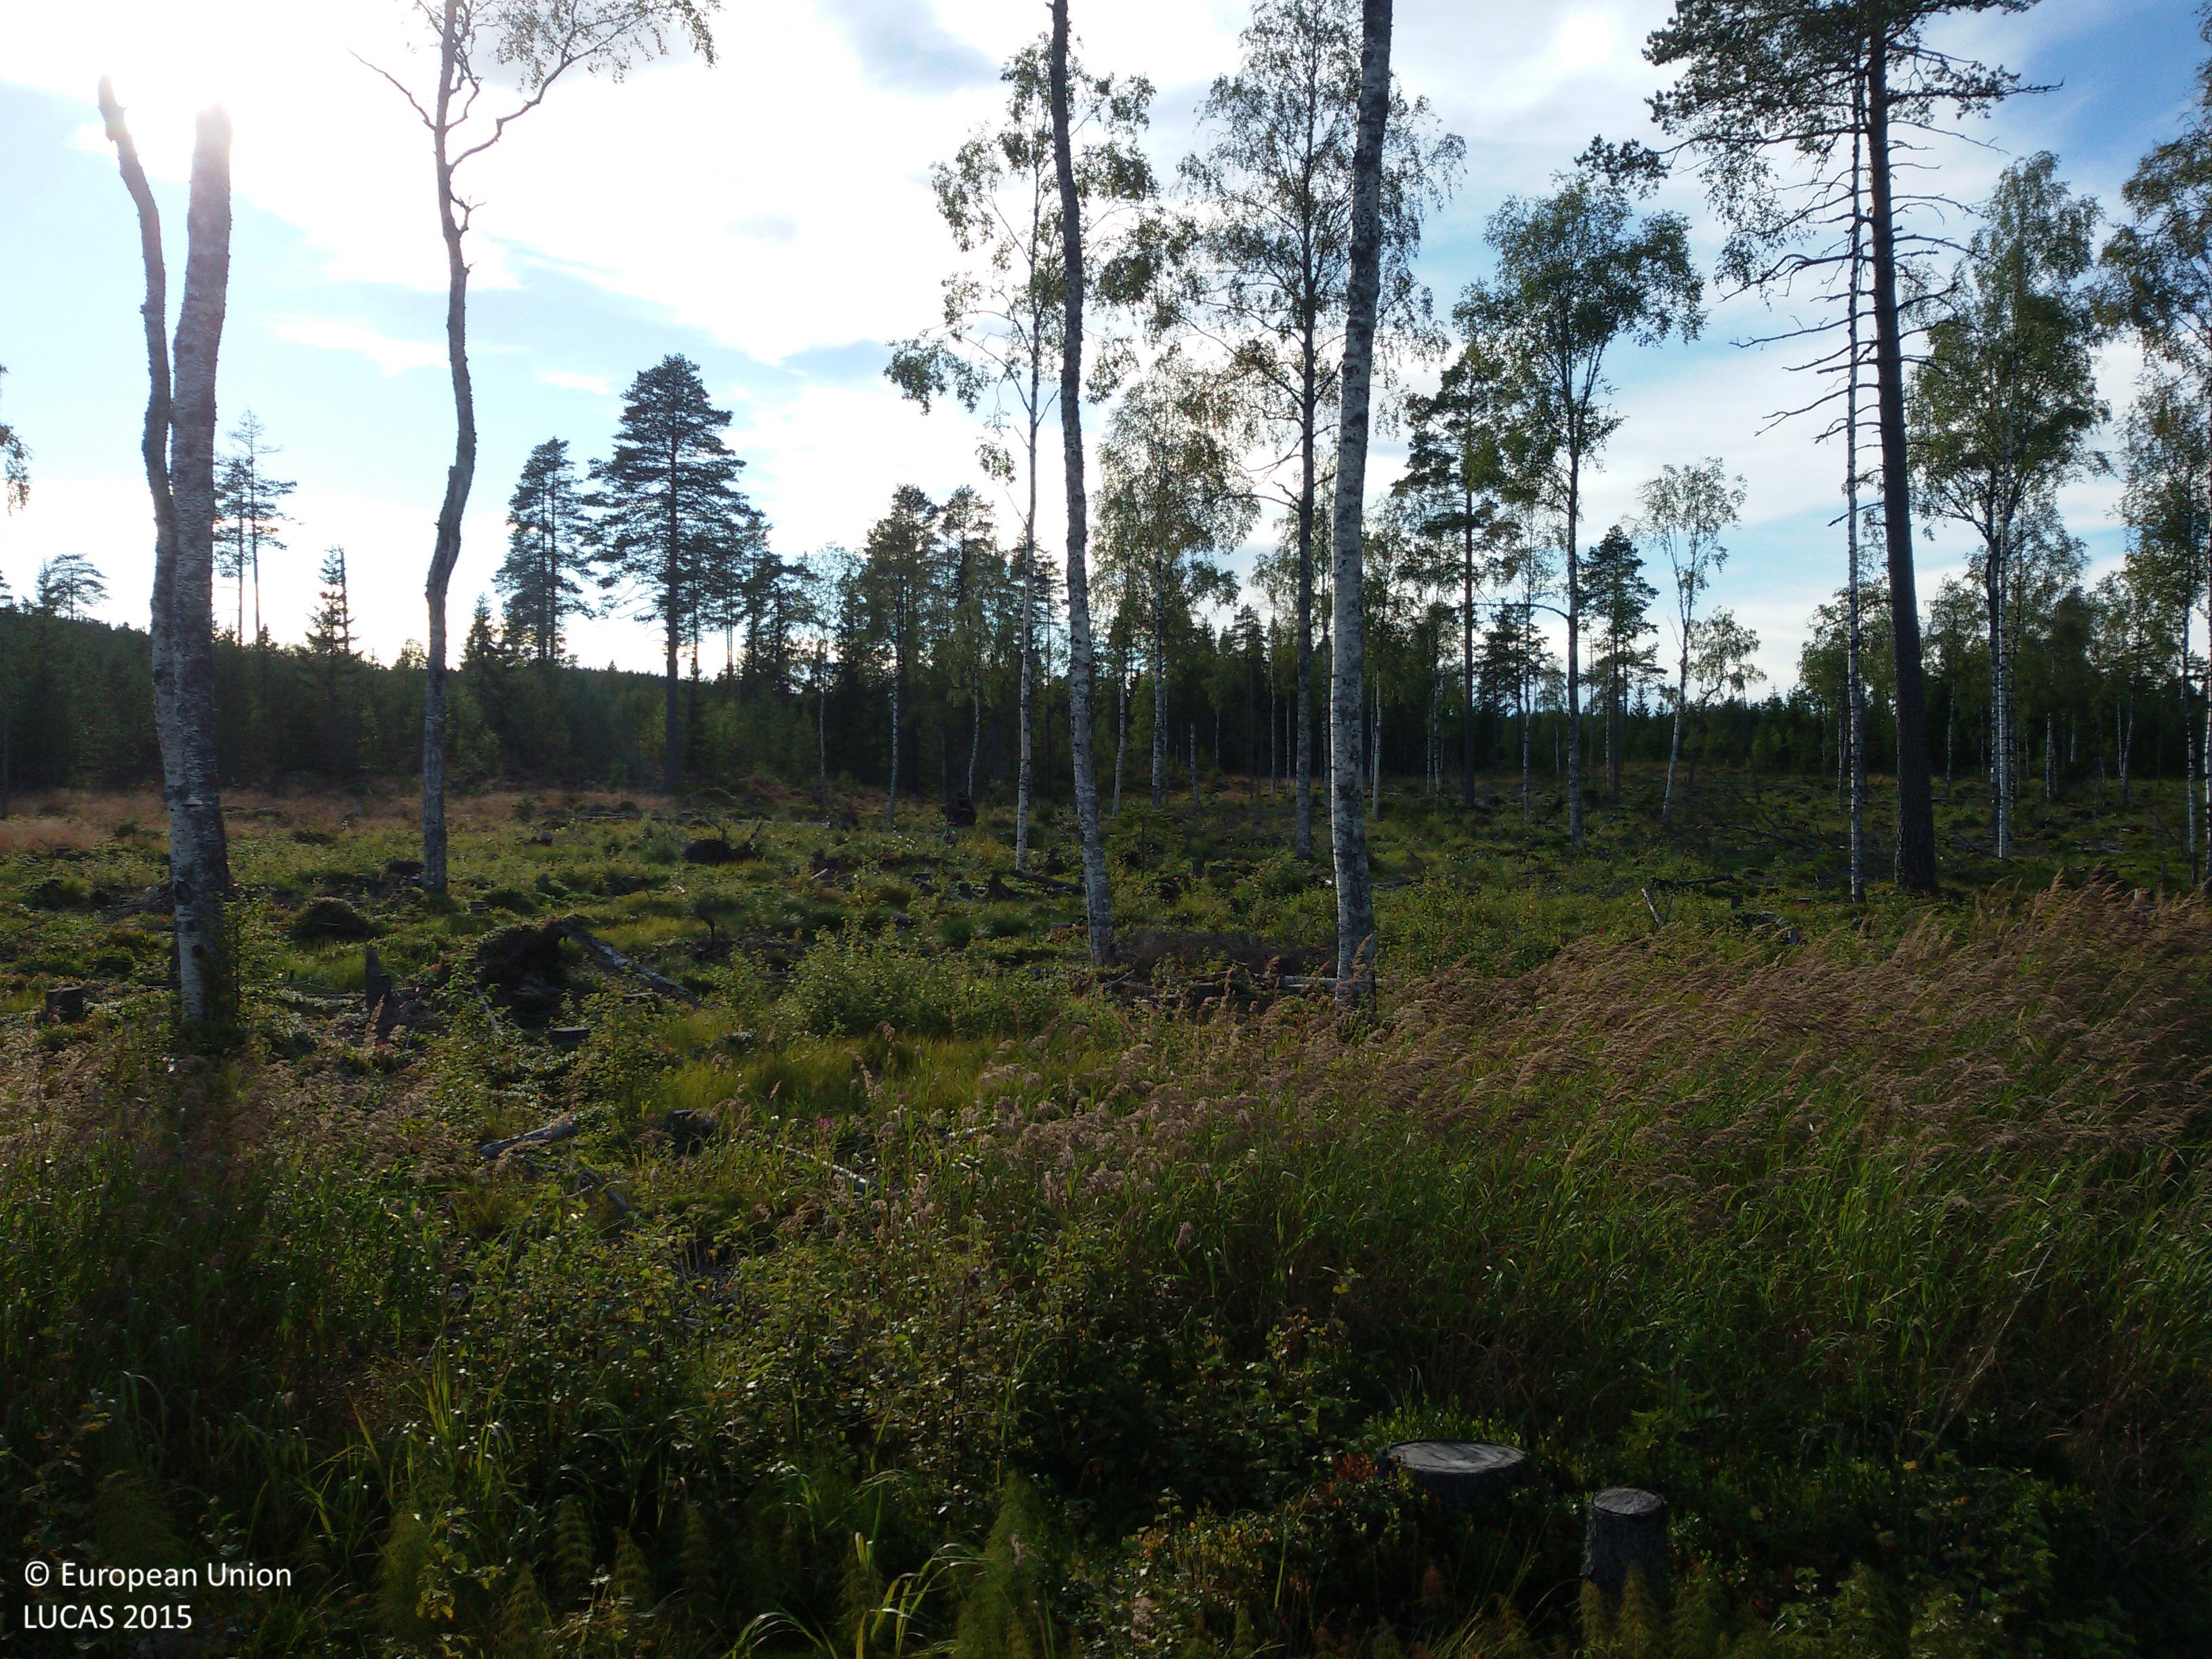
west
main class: Woodland
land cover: Spruce dominated coniferous woodland
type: boreal forest
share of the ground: > 75 %
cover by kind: coniferous forest trees 80 %, herbaceous plants 10 %, lichens and mosses 10 %
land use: Forestry
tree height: > 5 m
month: August
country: SE
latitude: 60.8476
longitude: 16.0043
